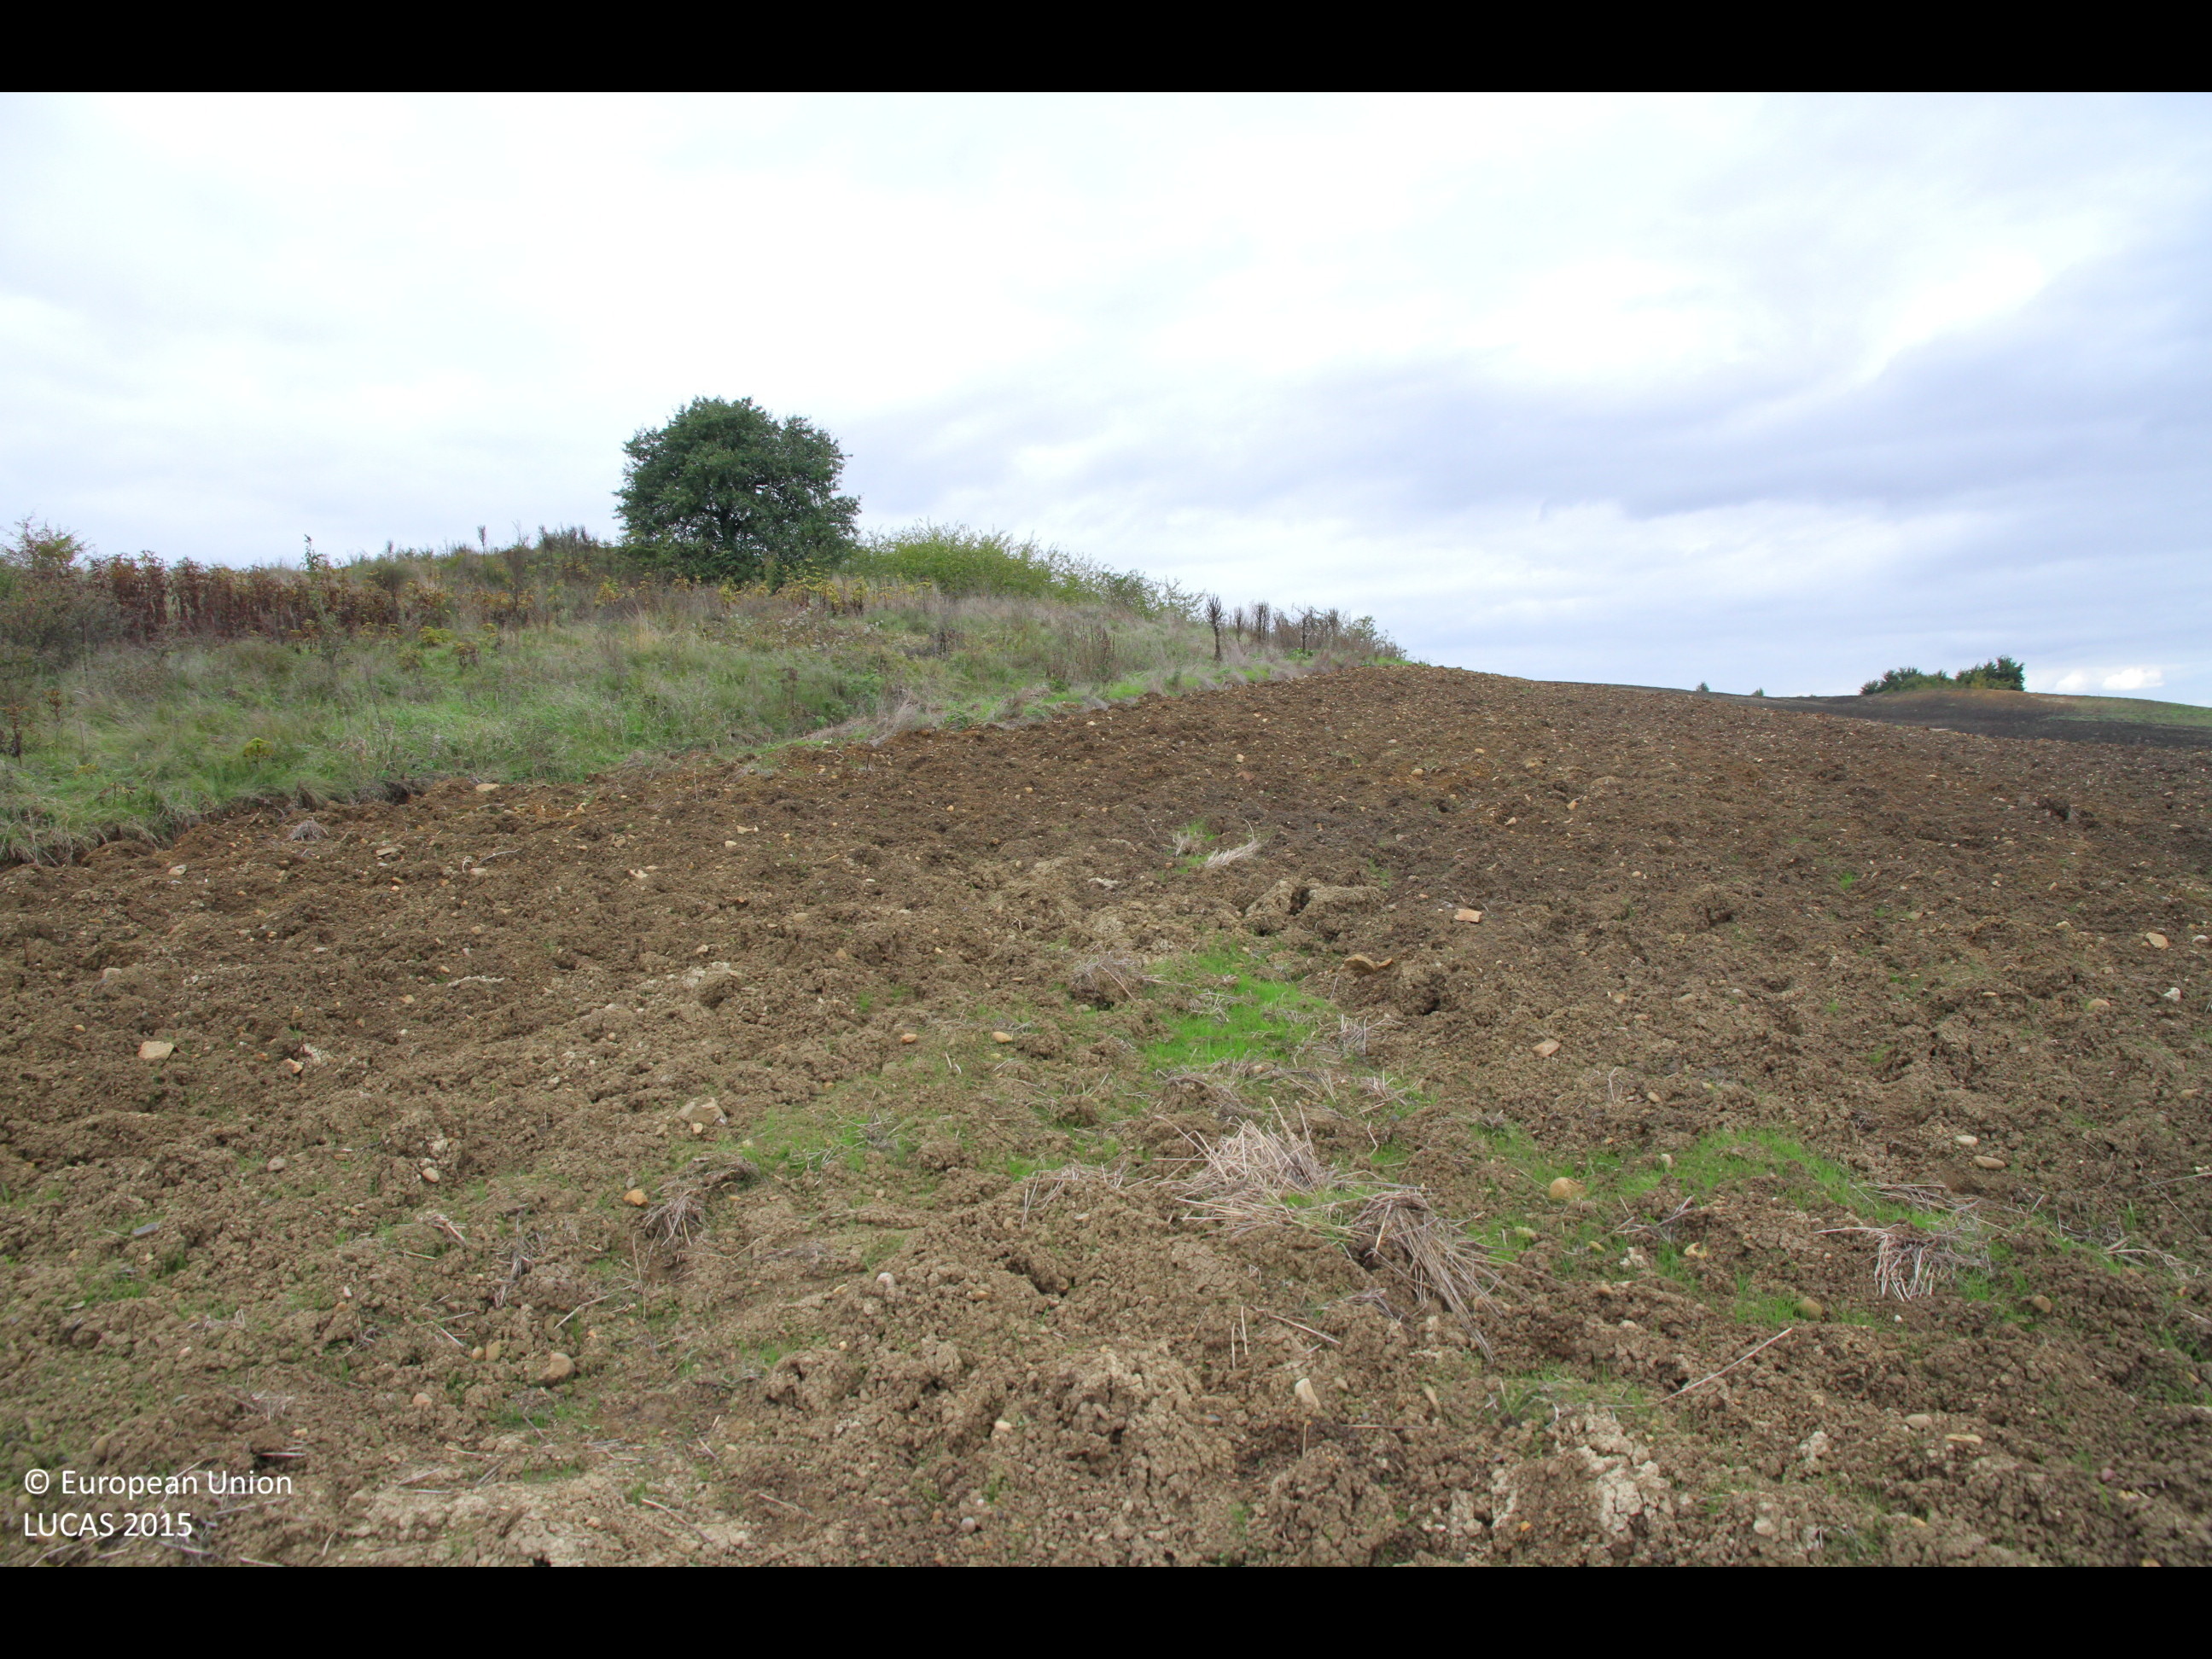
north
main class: Cropland
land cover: Common wheat
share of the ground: < 10 %
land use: Agriculture (excluding fallow land and kitchen gardens)
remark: Harvested field
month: October
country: BG
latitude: 43.1278
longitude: 27.1665
